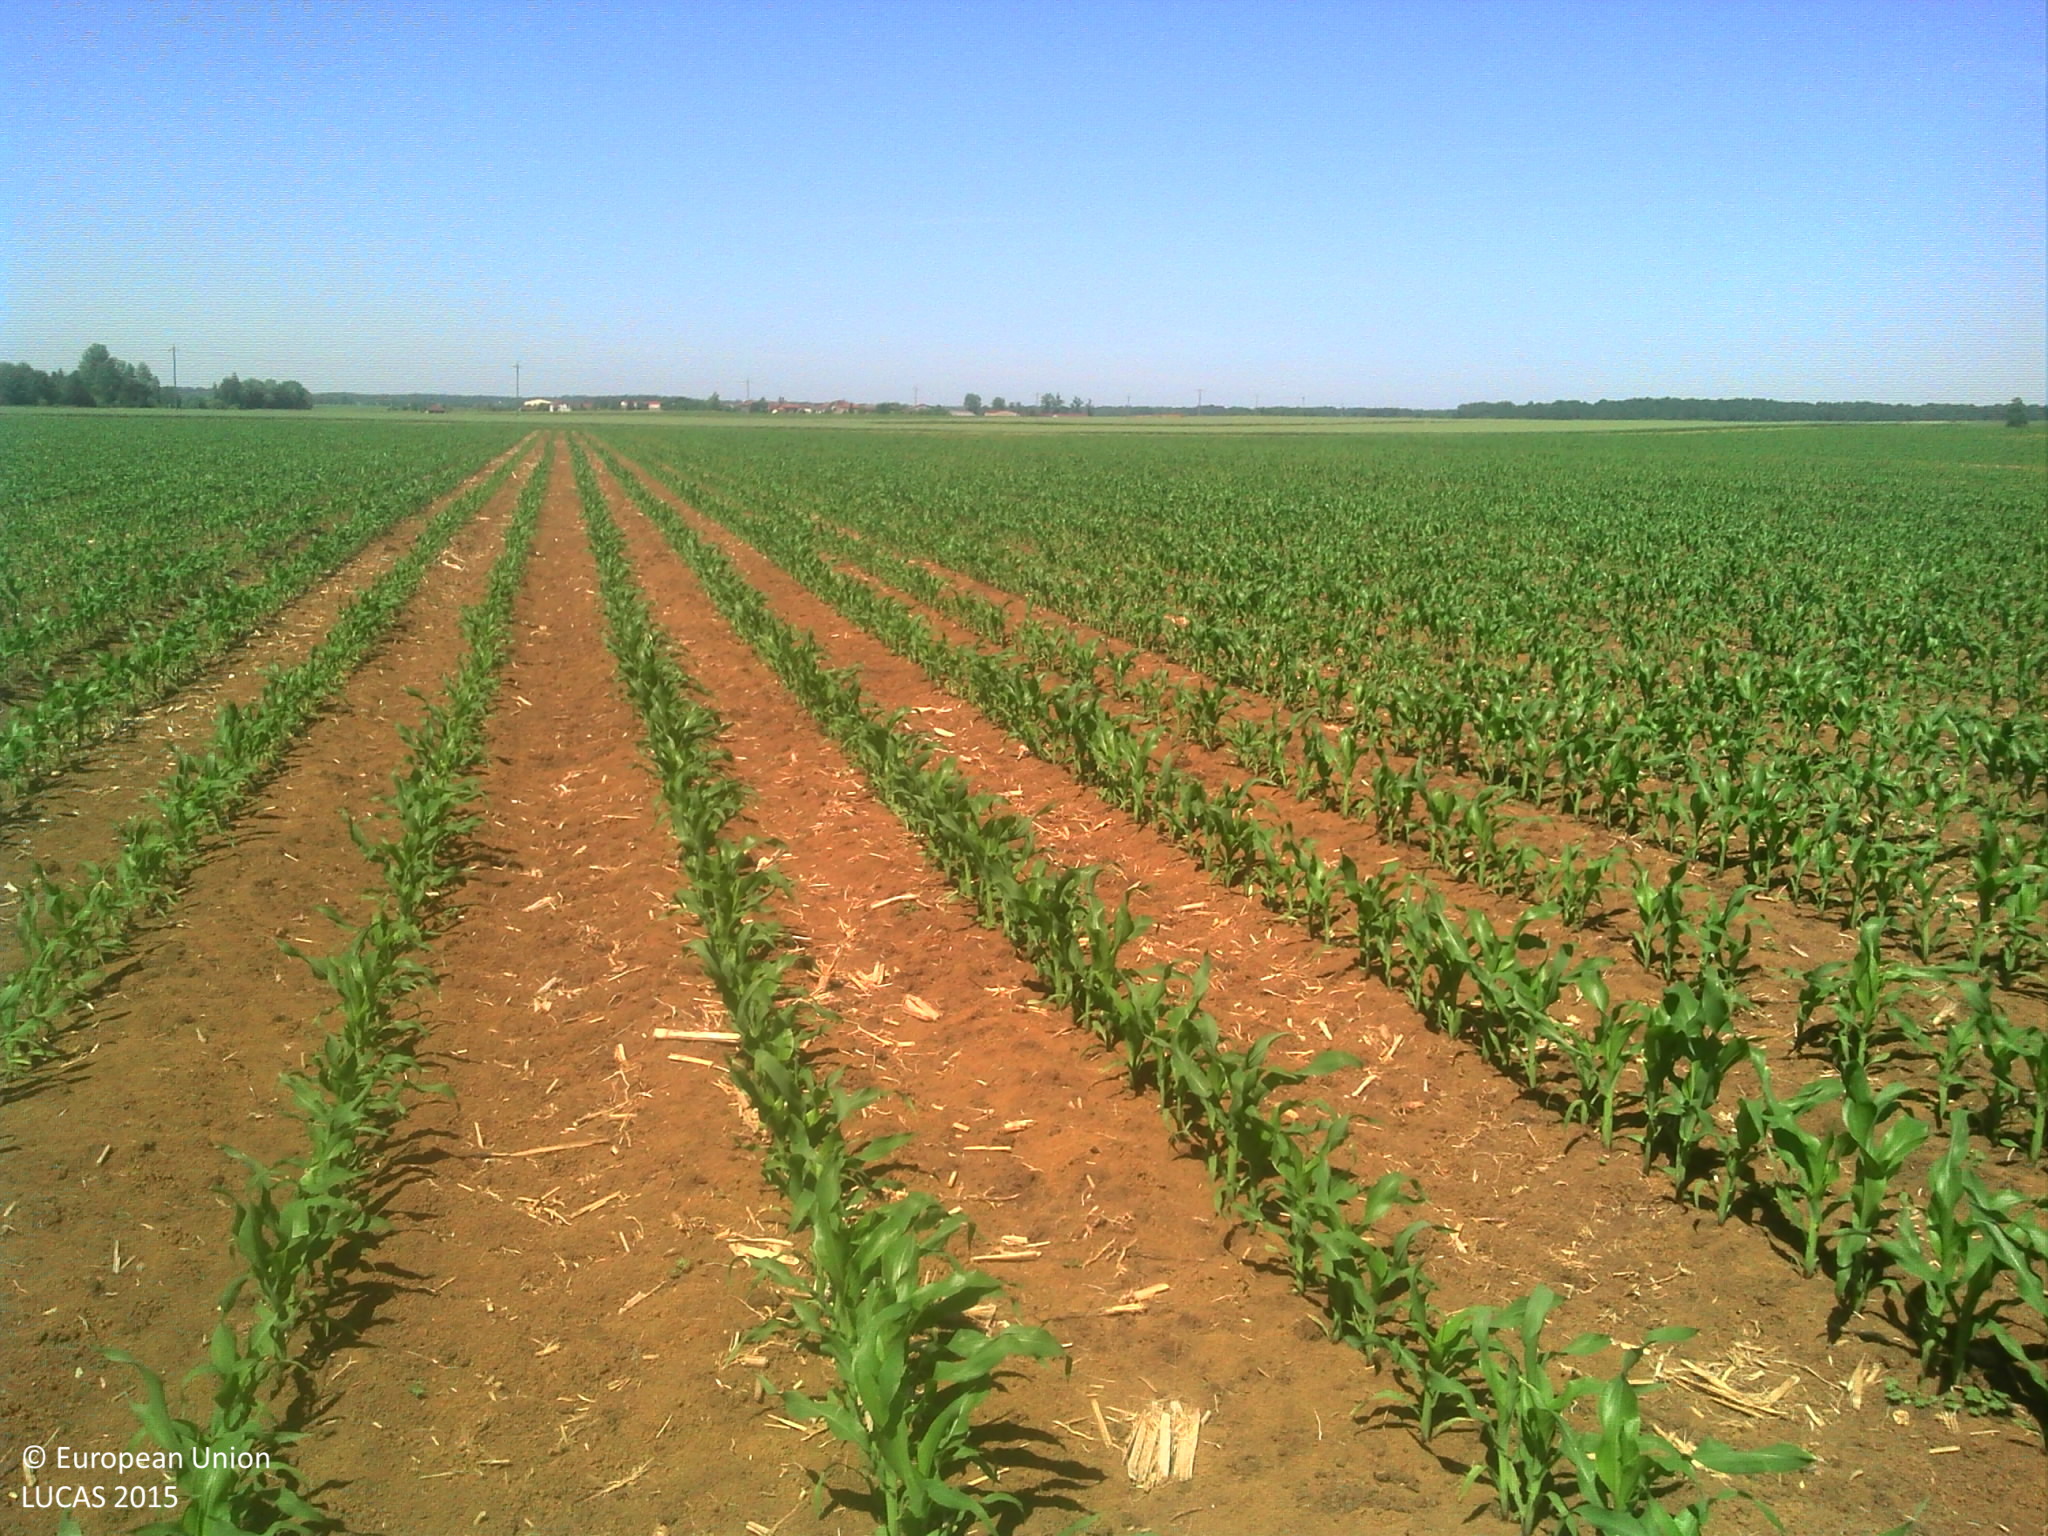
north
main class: Cropland
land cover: Maize
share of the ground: 10 - 25 %
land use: Agriculture (excluding fallow land and kitchen gardens)
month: June
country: FR
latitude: 48.4252
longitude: 4.7952
